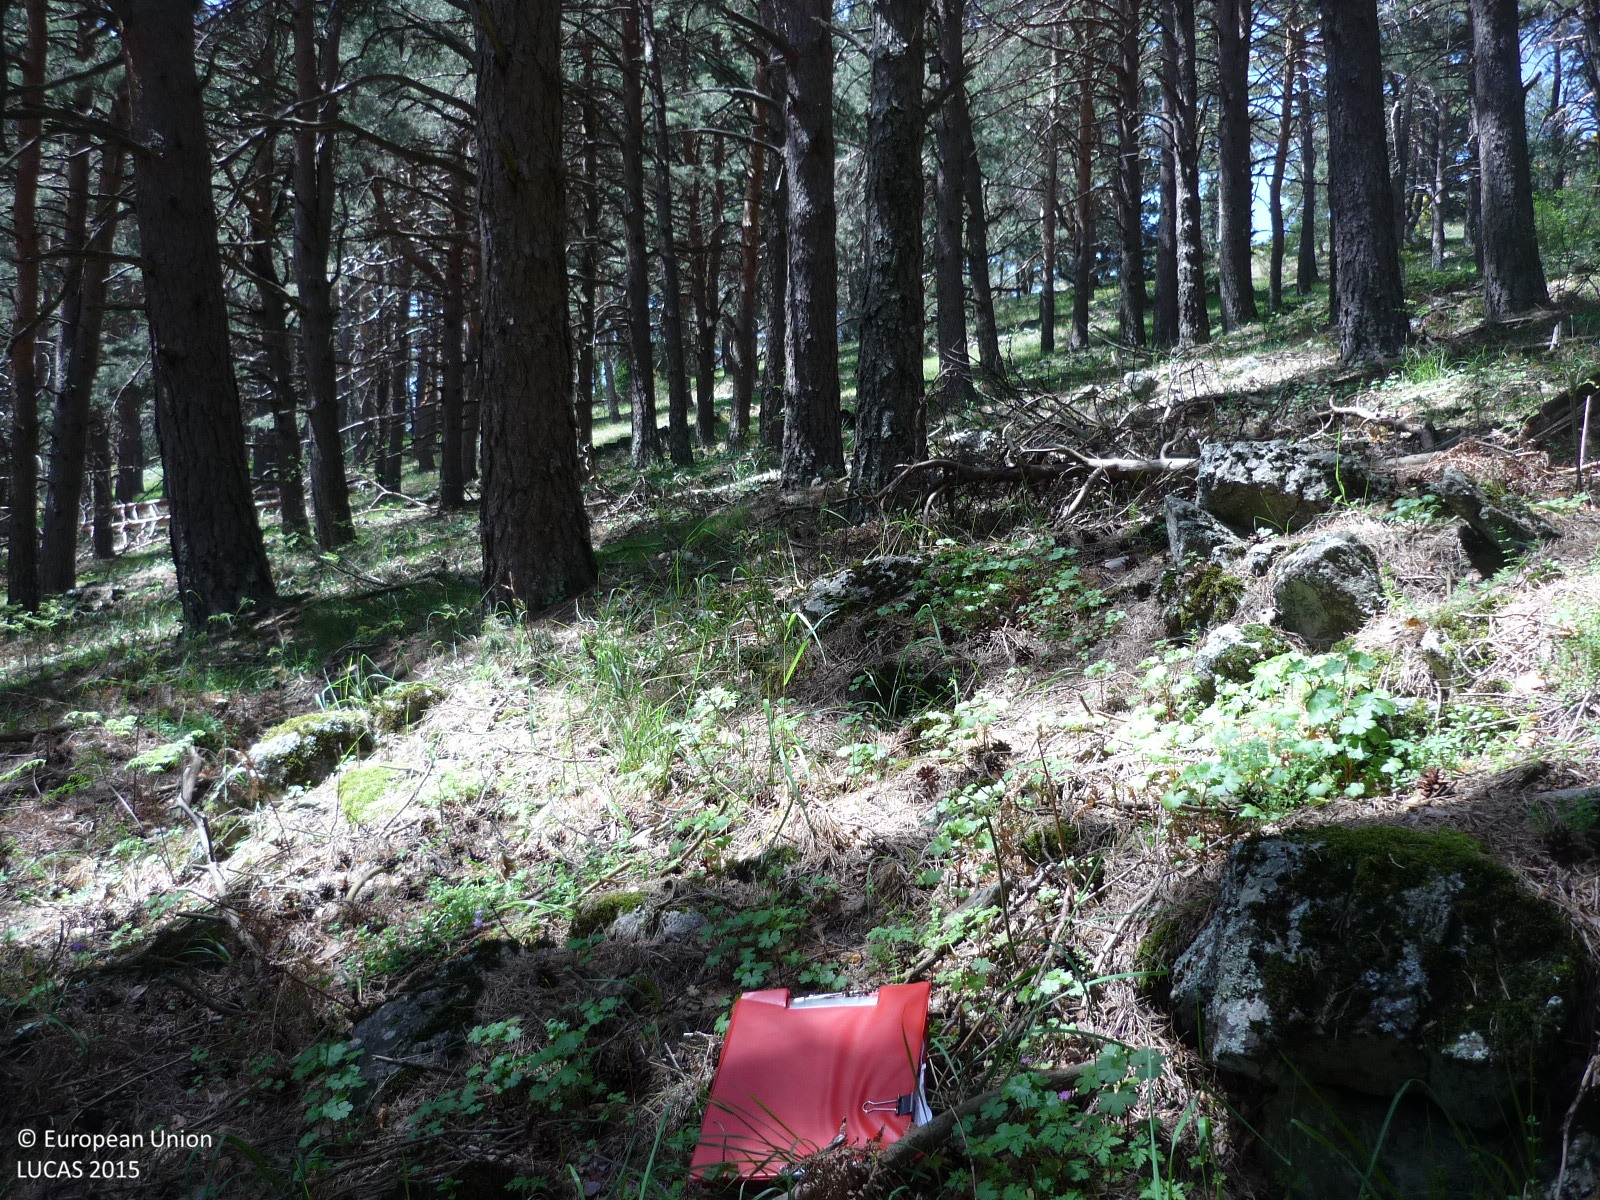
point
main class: Woodland
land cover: Pine dominated coniferous woodland
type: coniferous forest of the mediterranean region
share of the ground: > 75 %
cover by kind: coniferous forest trees 90 %, herbaceous plants 10 %
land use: Forestry
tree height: > 5 m
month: May
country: ES
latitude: 40.8066
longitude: -3.8063
